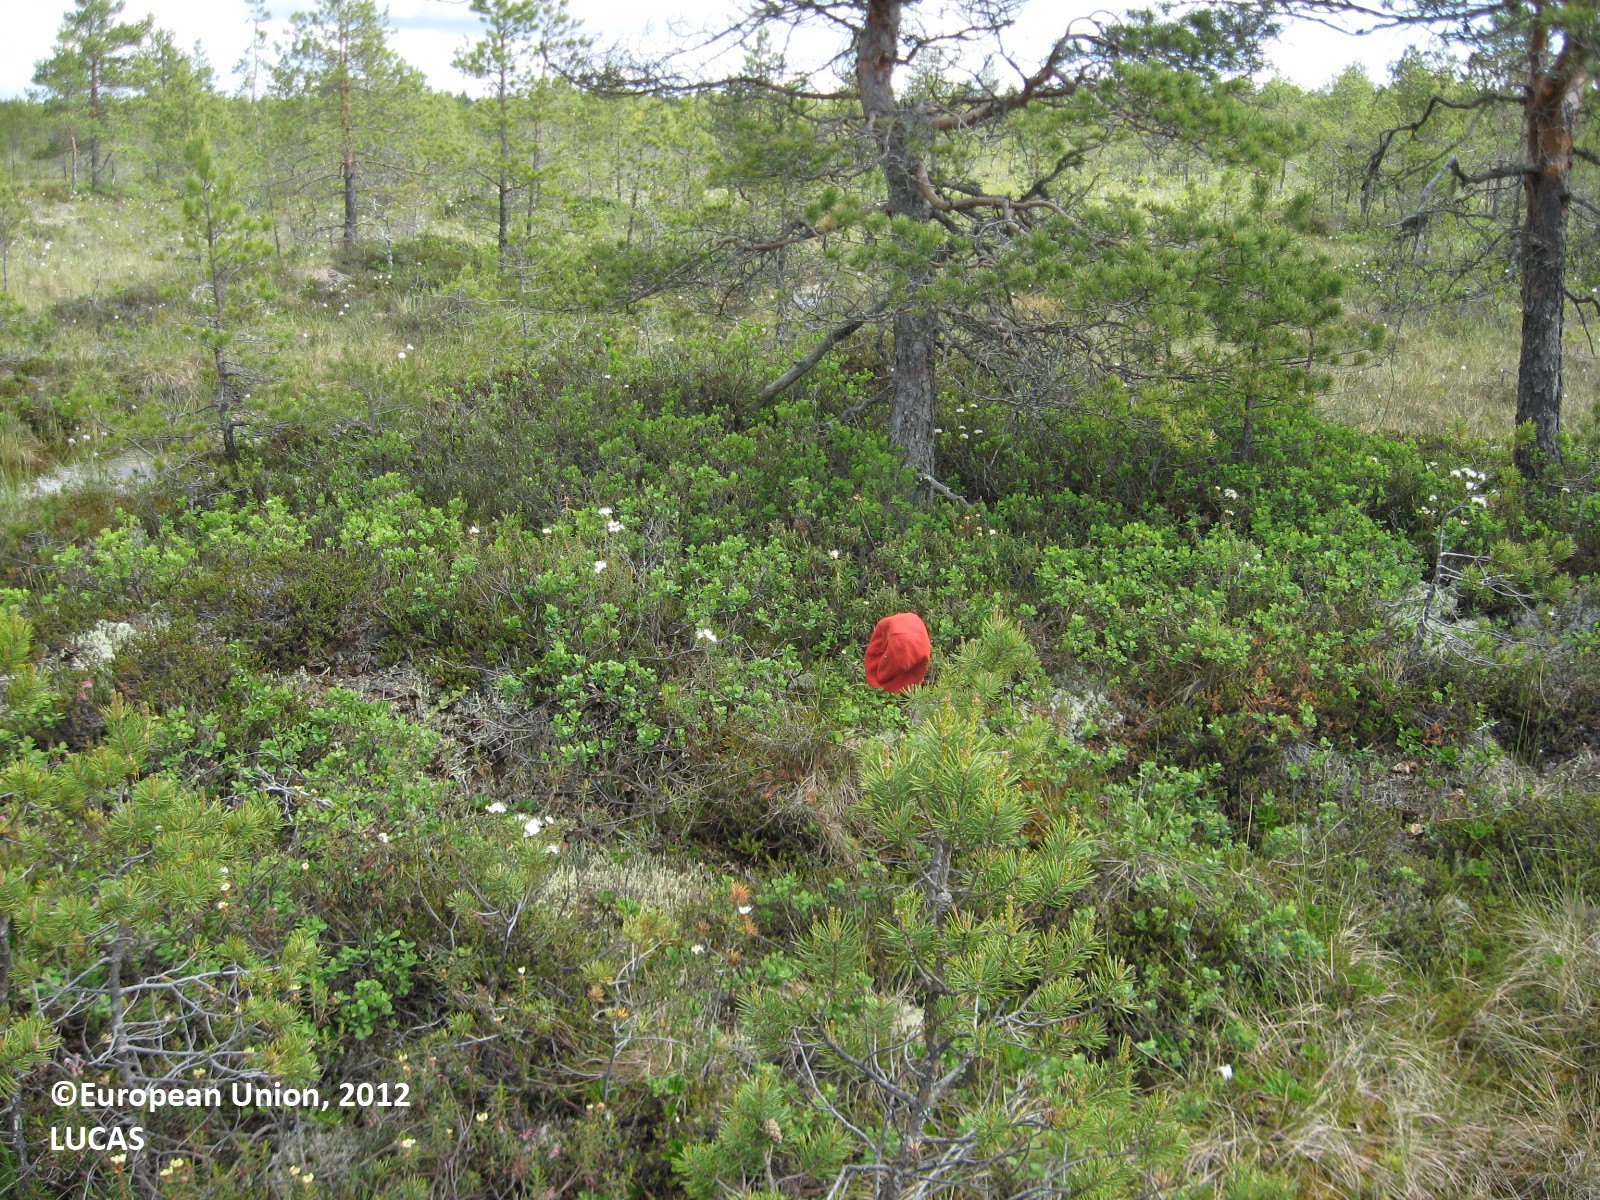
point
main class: Woodland
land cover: Pine dominated coniferous woodland
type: mire and swamp forests
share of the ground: 25 - 50 %
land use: Forestry
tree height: > 5 m
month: June
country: FI
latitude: 63.0997
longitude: 22.6729
